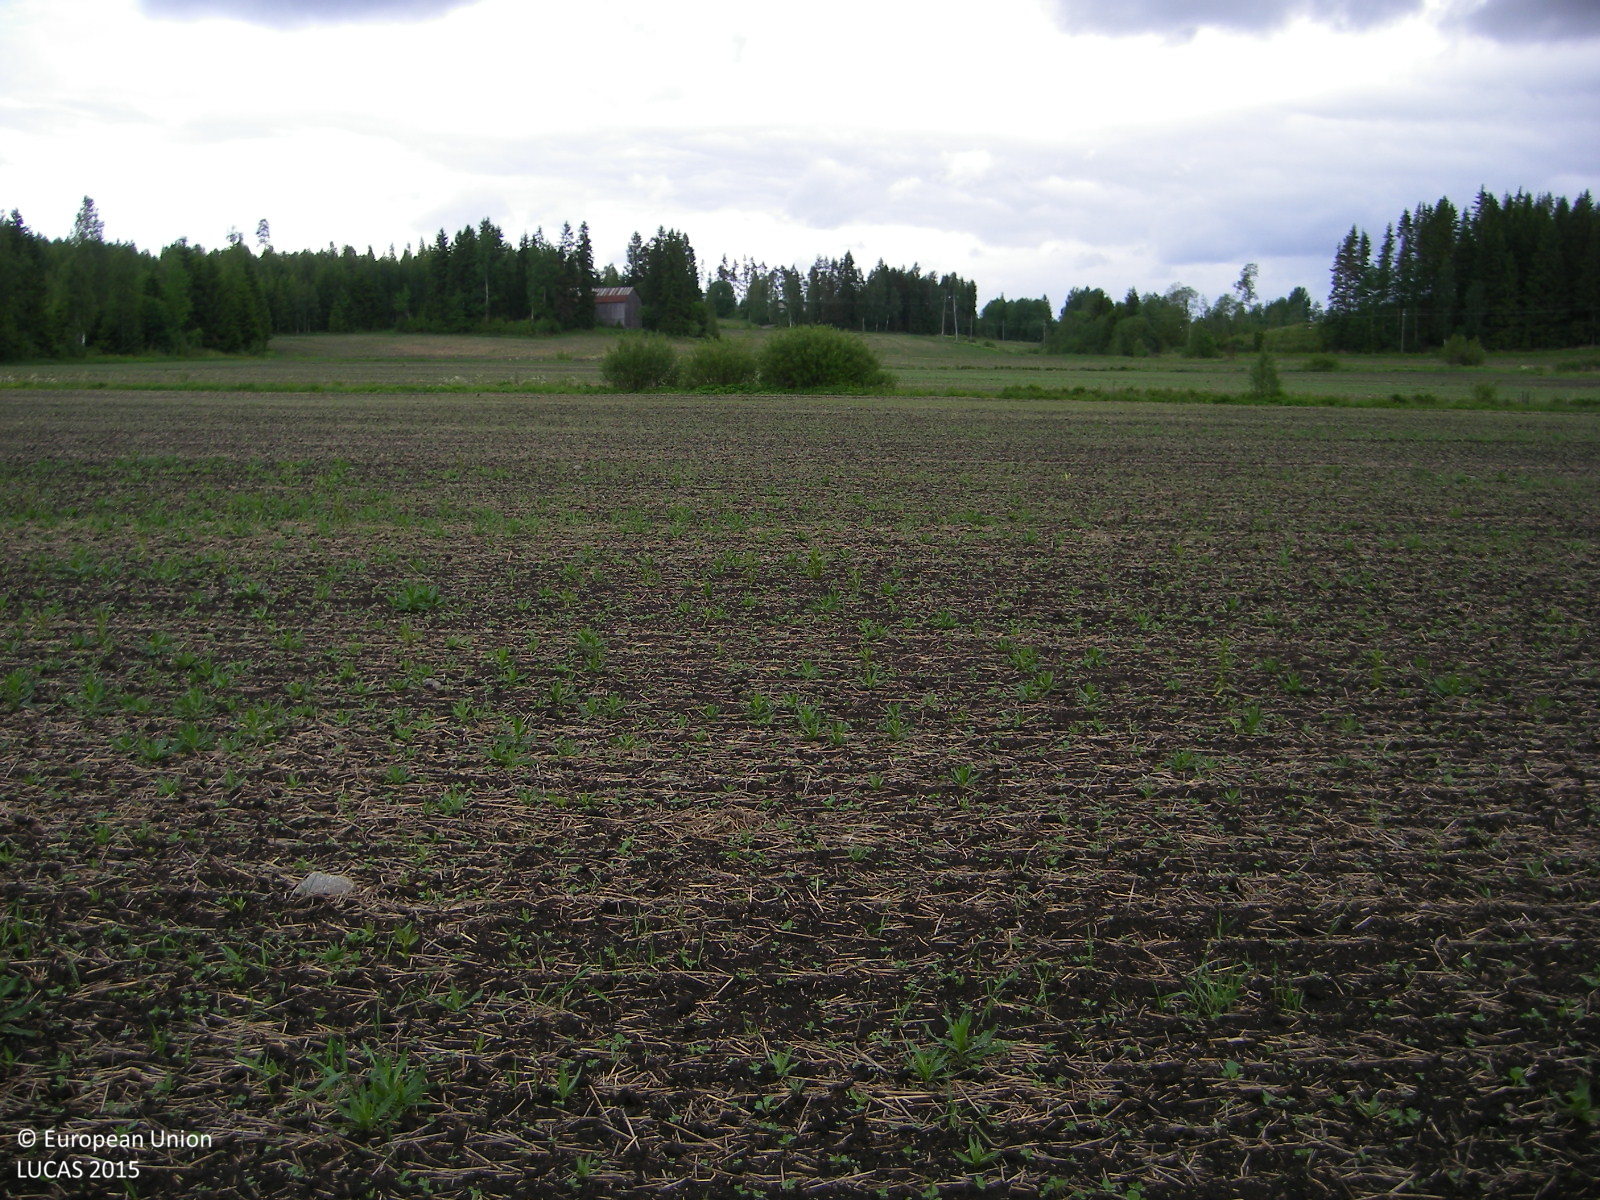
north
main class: Cropland
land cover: Other root crops
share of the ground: 10 - 25 %
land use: Agriculture (excluding fallow land and kitchen gardens)
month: June
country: FI
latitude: 60.2621
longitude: 24.2174
